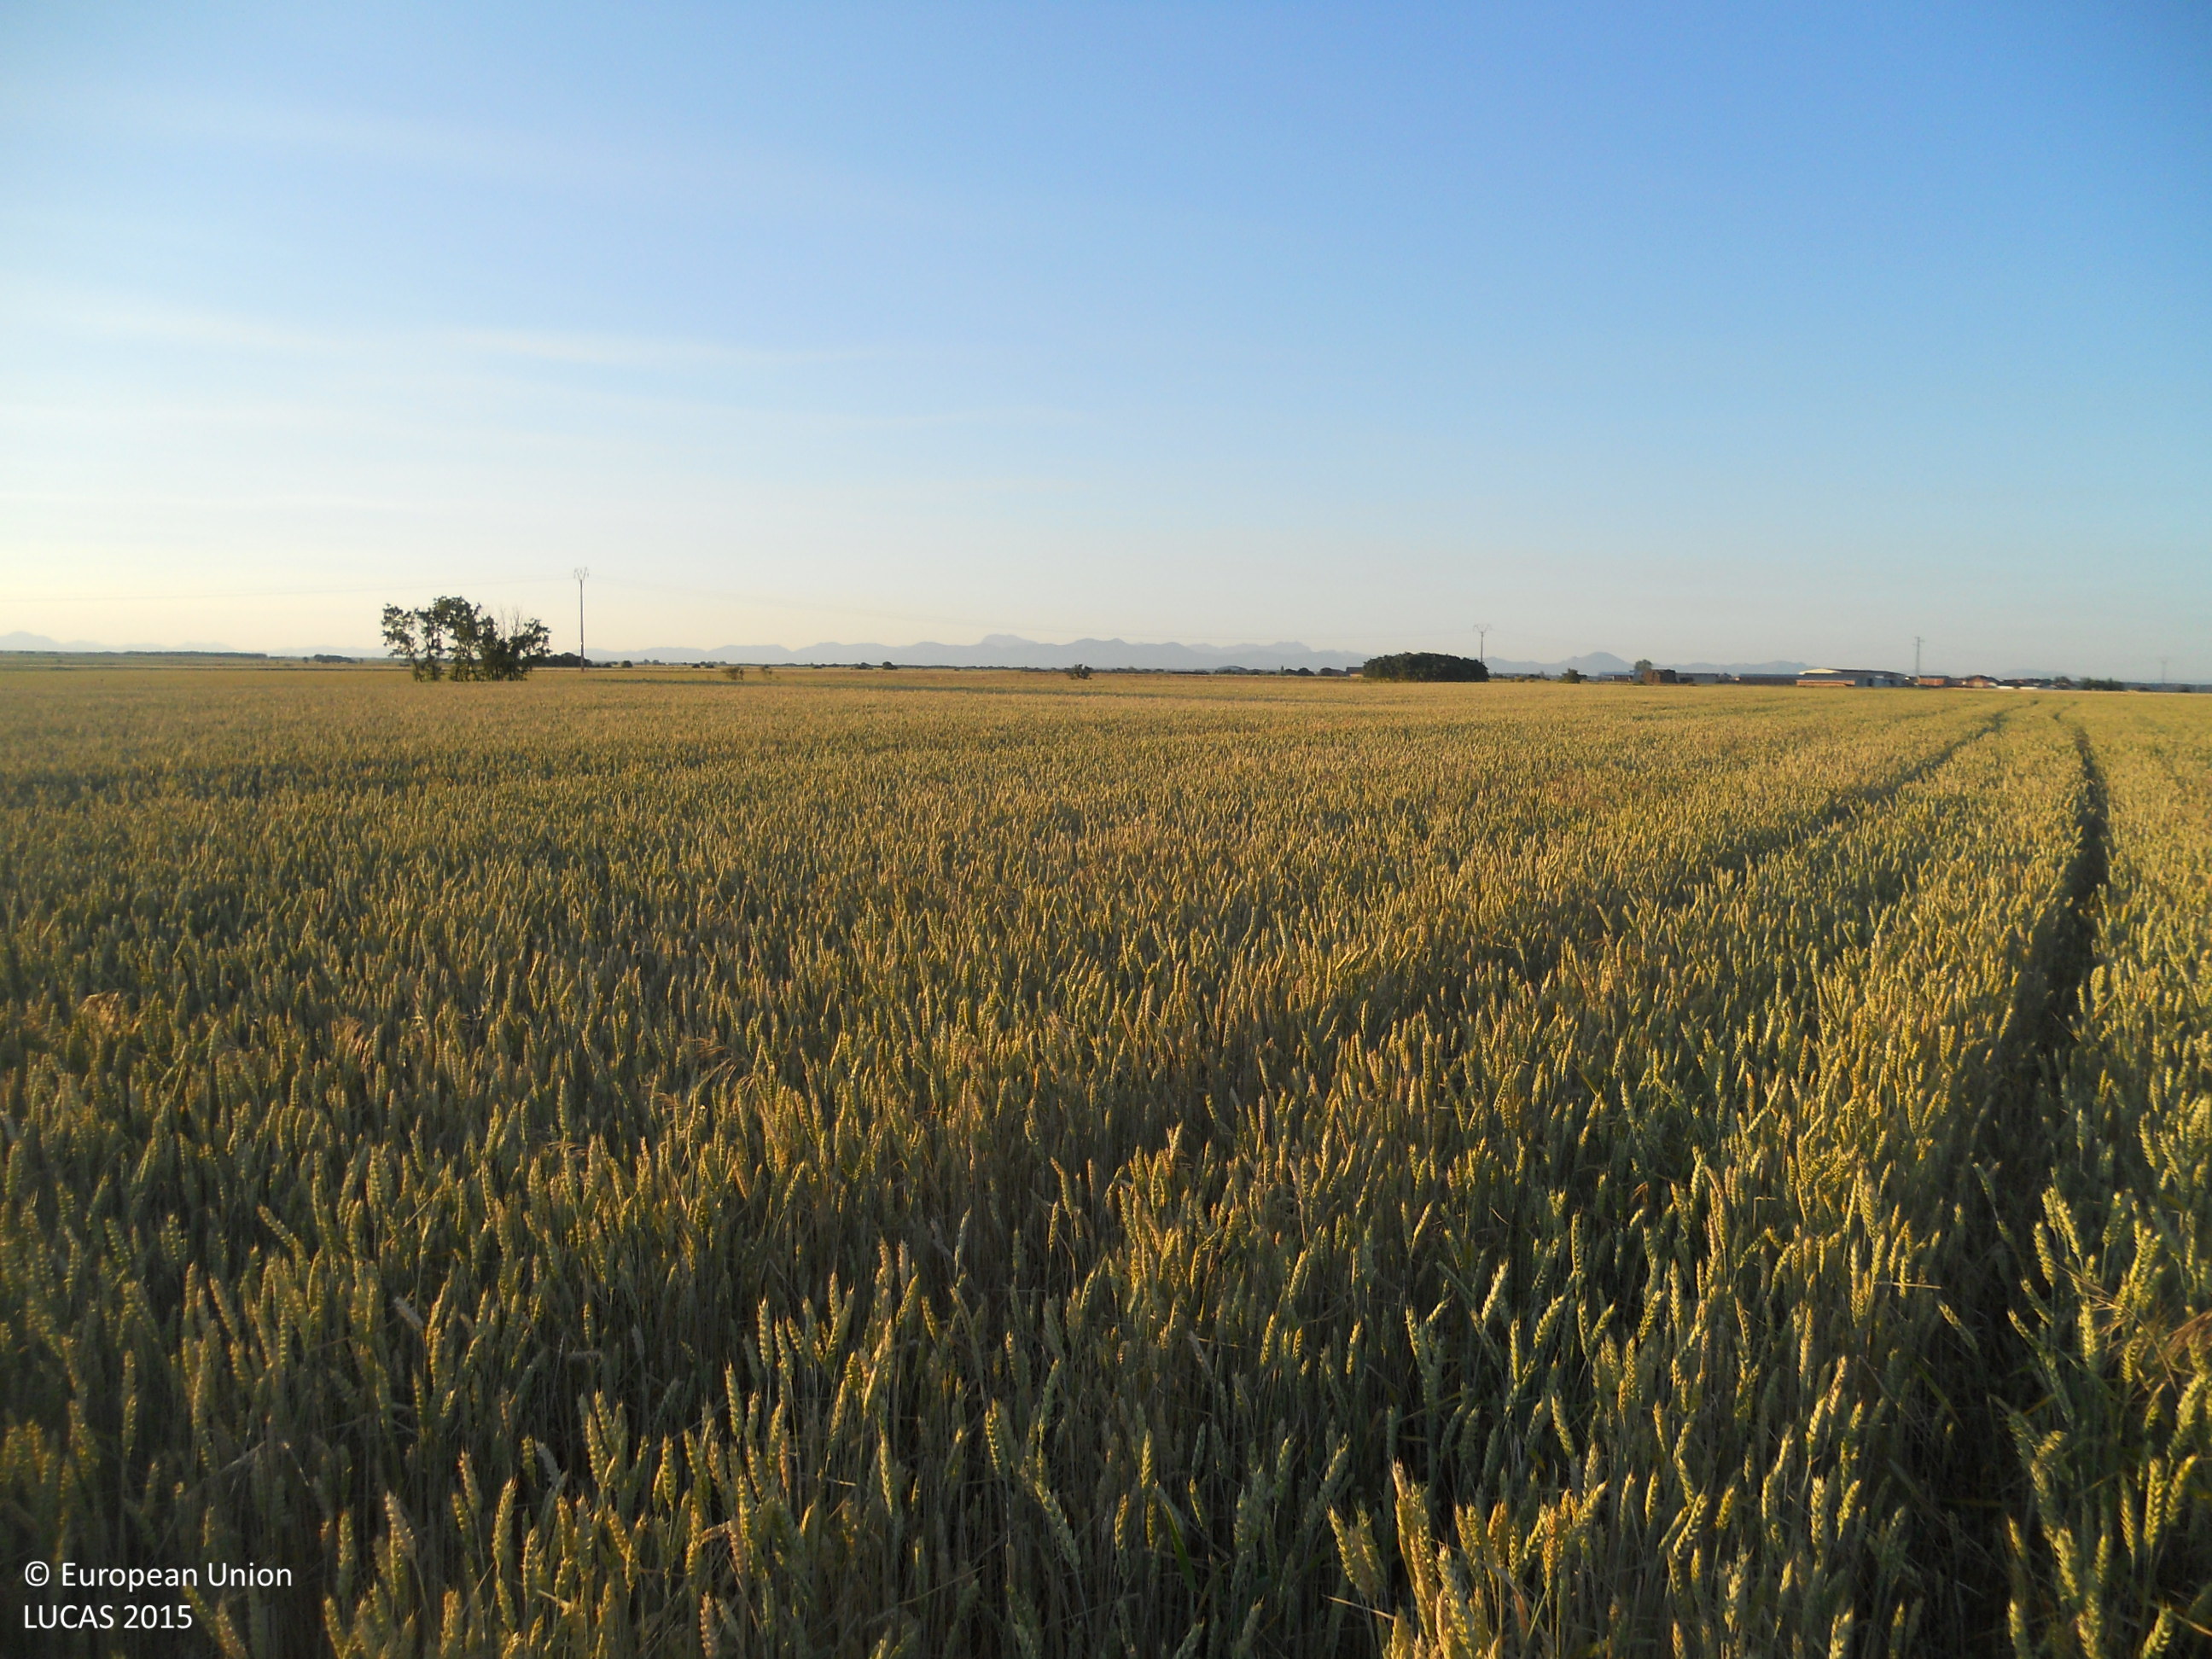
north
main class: Cropland
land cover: Common wheat
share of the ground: > 75 %
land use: Agriculture (excluding fallow land and kitchen gardens)
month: June
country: ES
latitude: 42.4747
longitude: -4.8108
